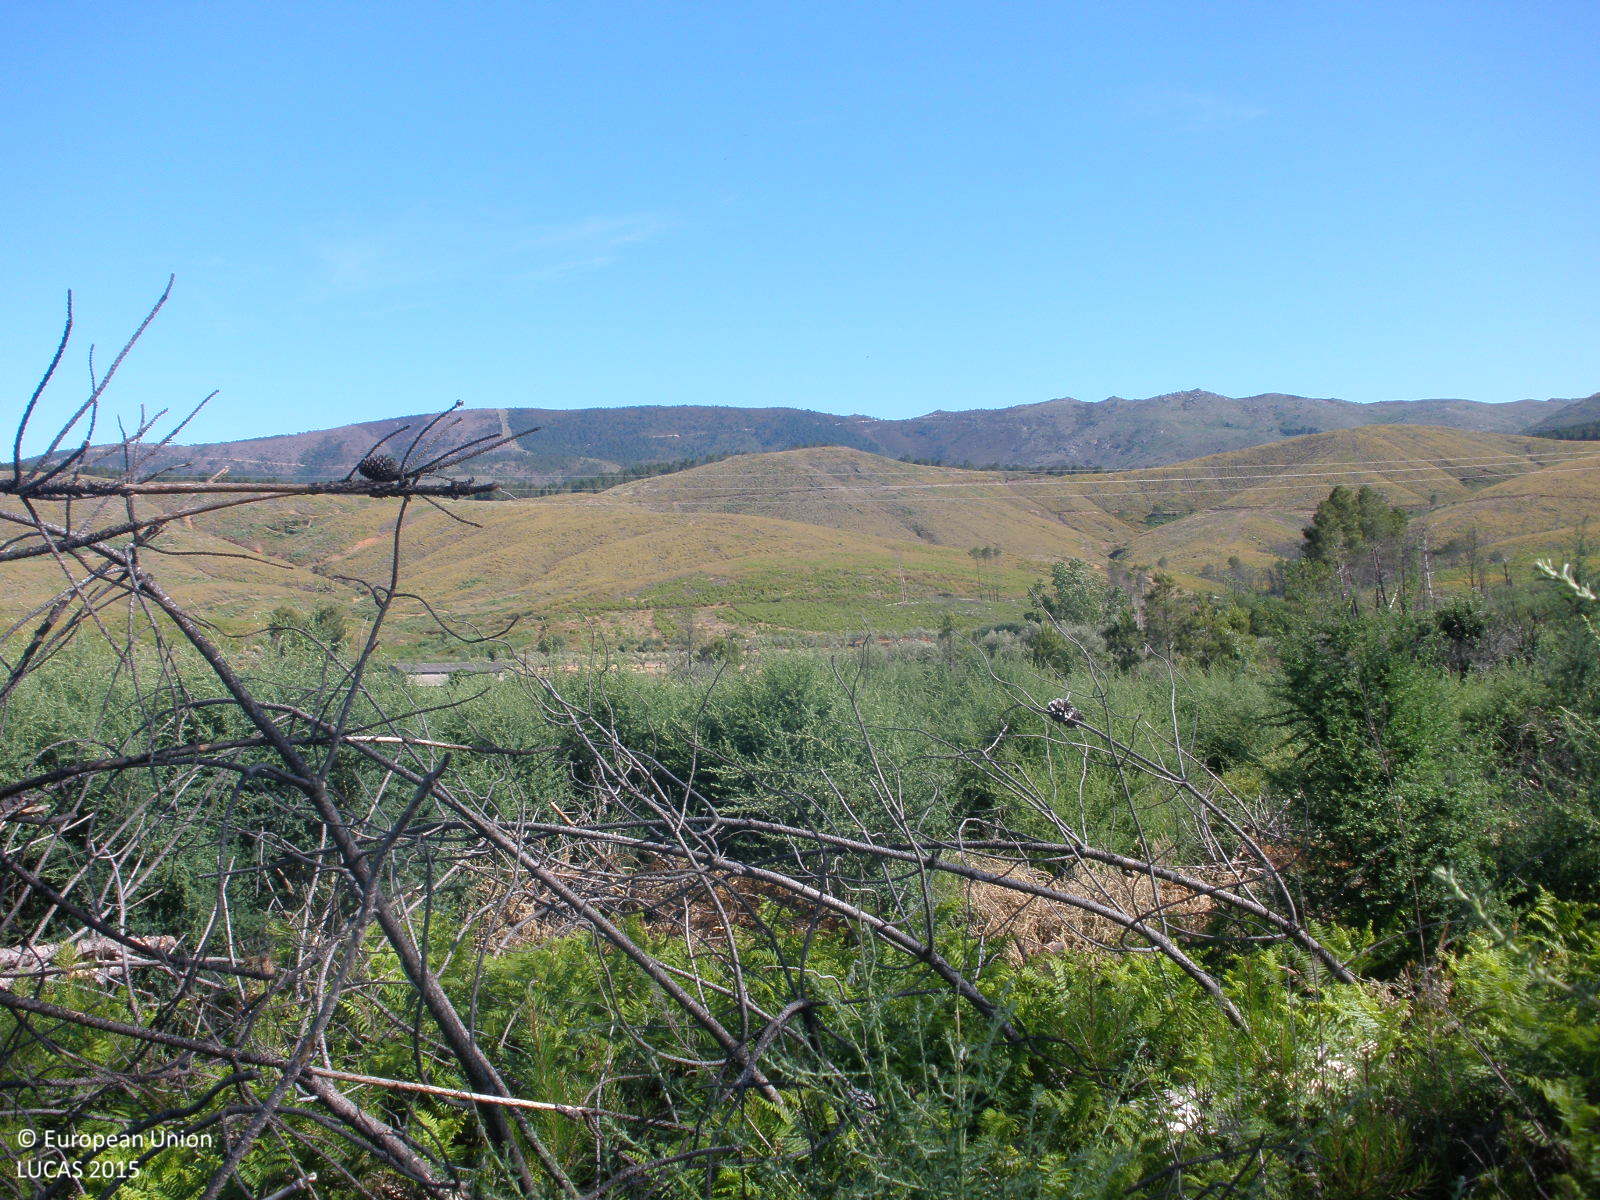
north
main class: Shrubland
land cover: Shrubland without tree cover
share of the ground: > 75 %
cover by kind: shrubs 80 %, herbaceous plants 20 %
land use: Forestry
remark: Burnt area
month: May
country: ES
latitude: 40.2204
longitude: -6.6195
